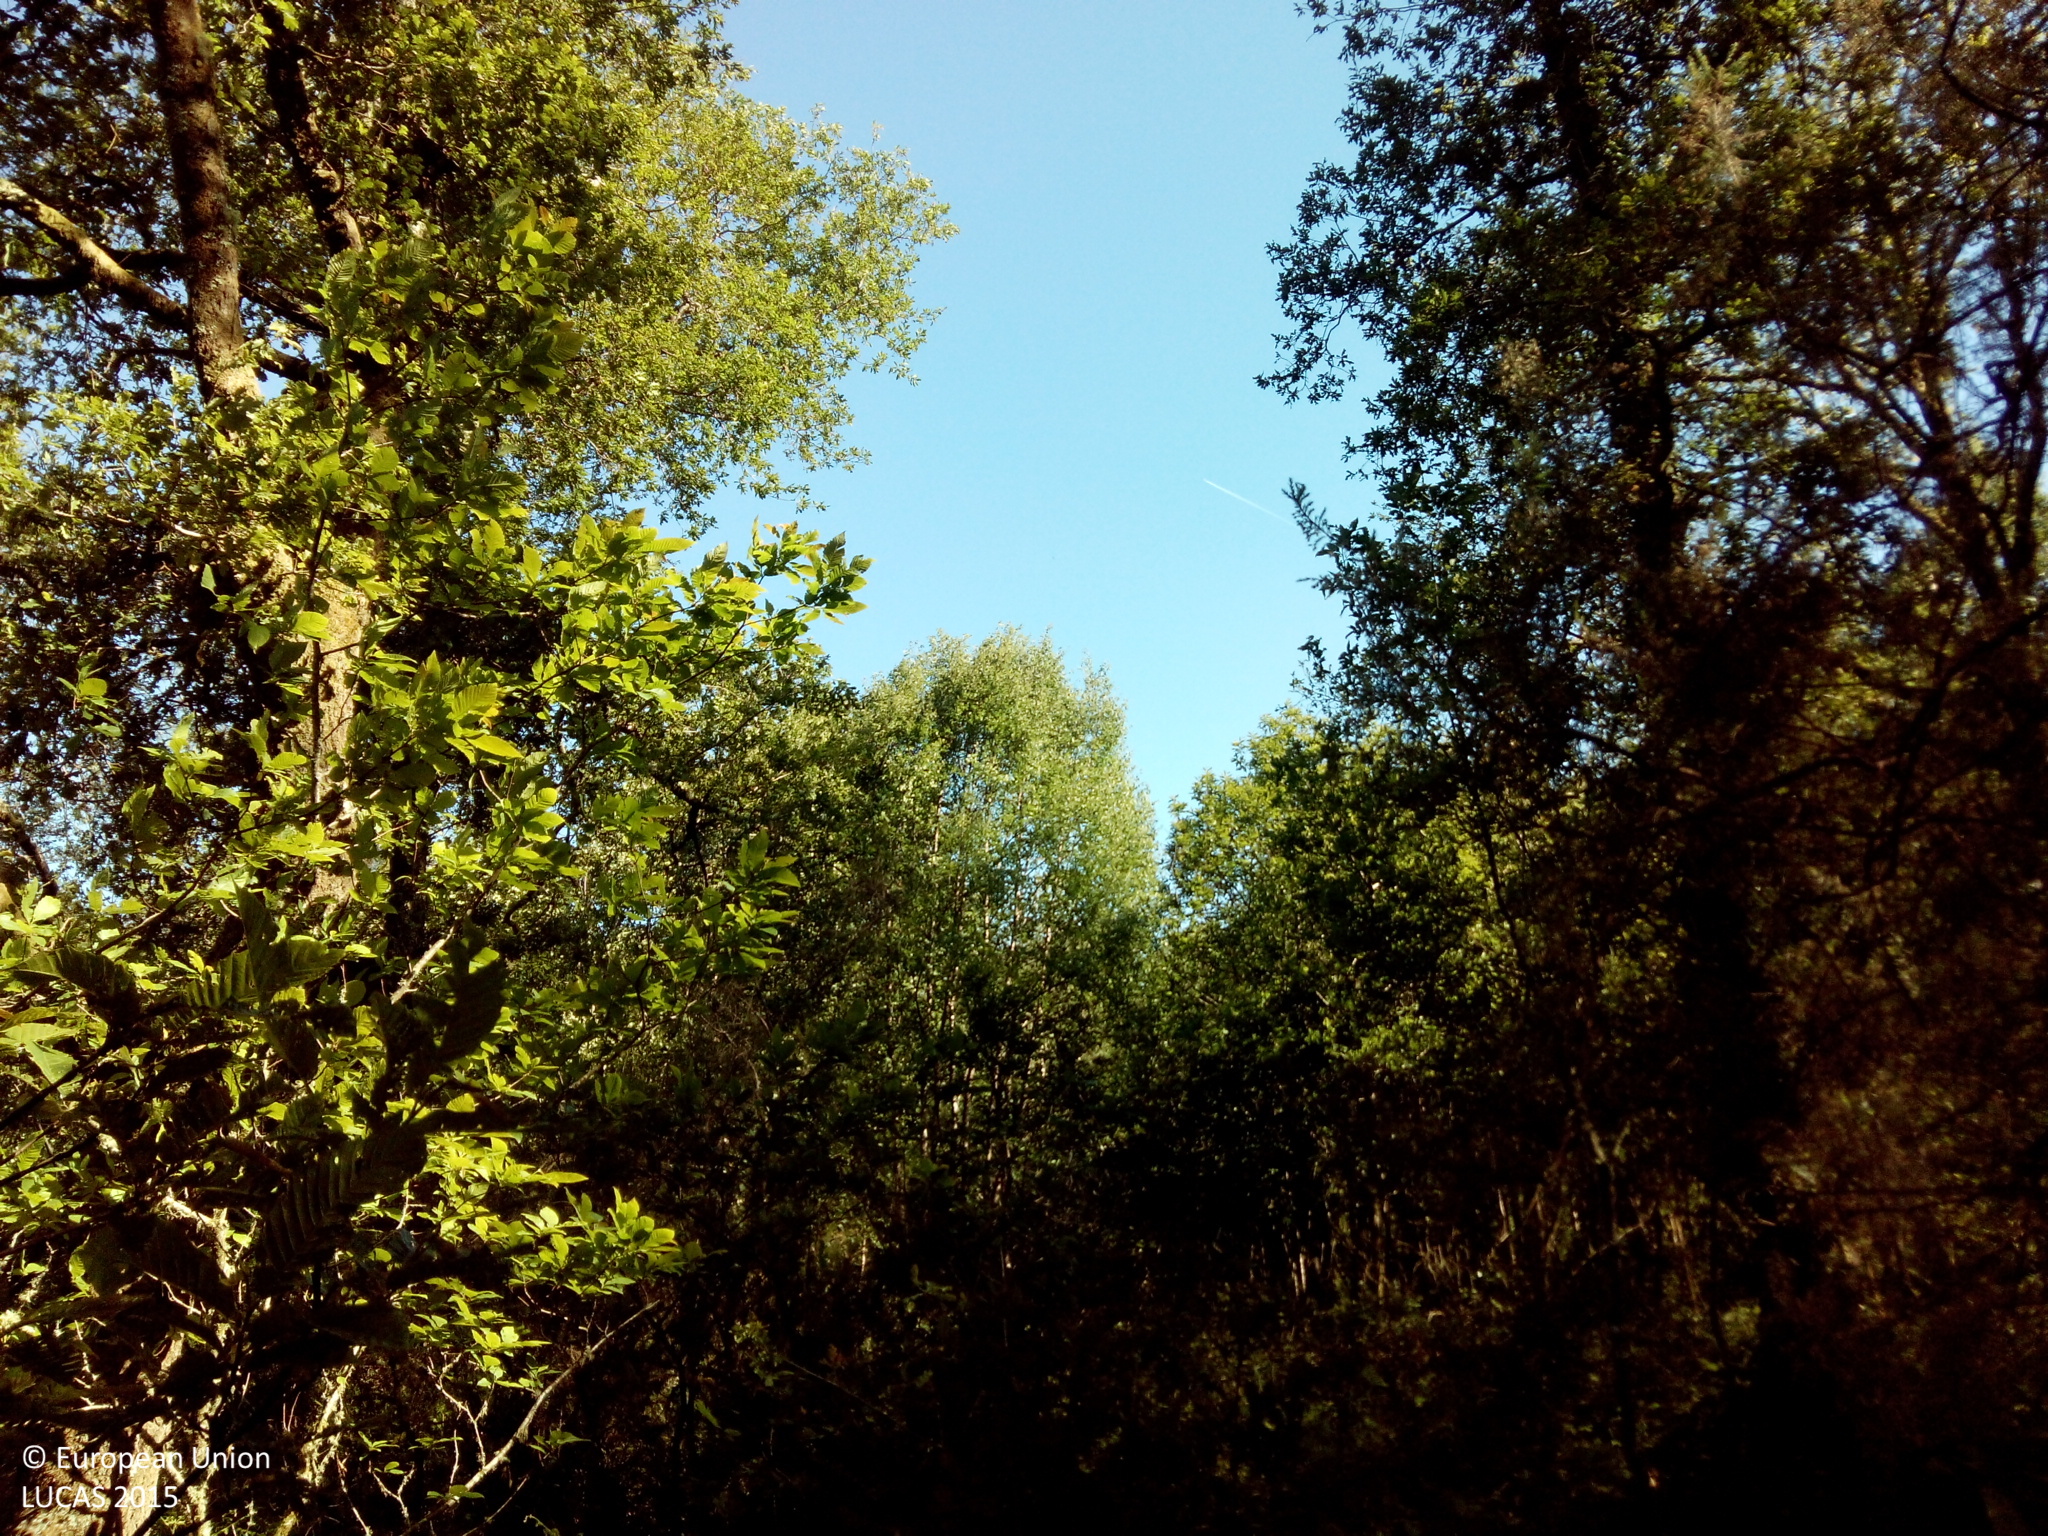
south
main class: Woodland
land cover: Broadleaved woodland
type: acidophilous oak and oak-birch forest
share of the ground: > 75 %
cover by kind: broadleaved forest trees 100 %
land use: Forestry
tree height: > 5 m
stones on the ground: 10 - 25 %
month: May
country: ES
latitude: 42.6364
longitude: -8.3767
